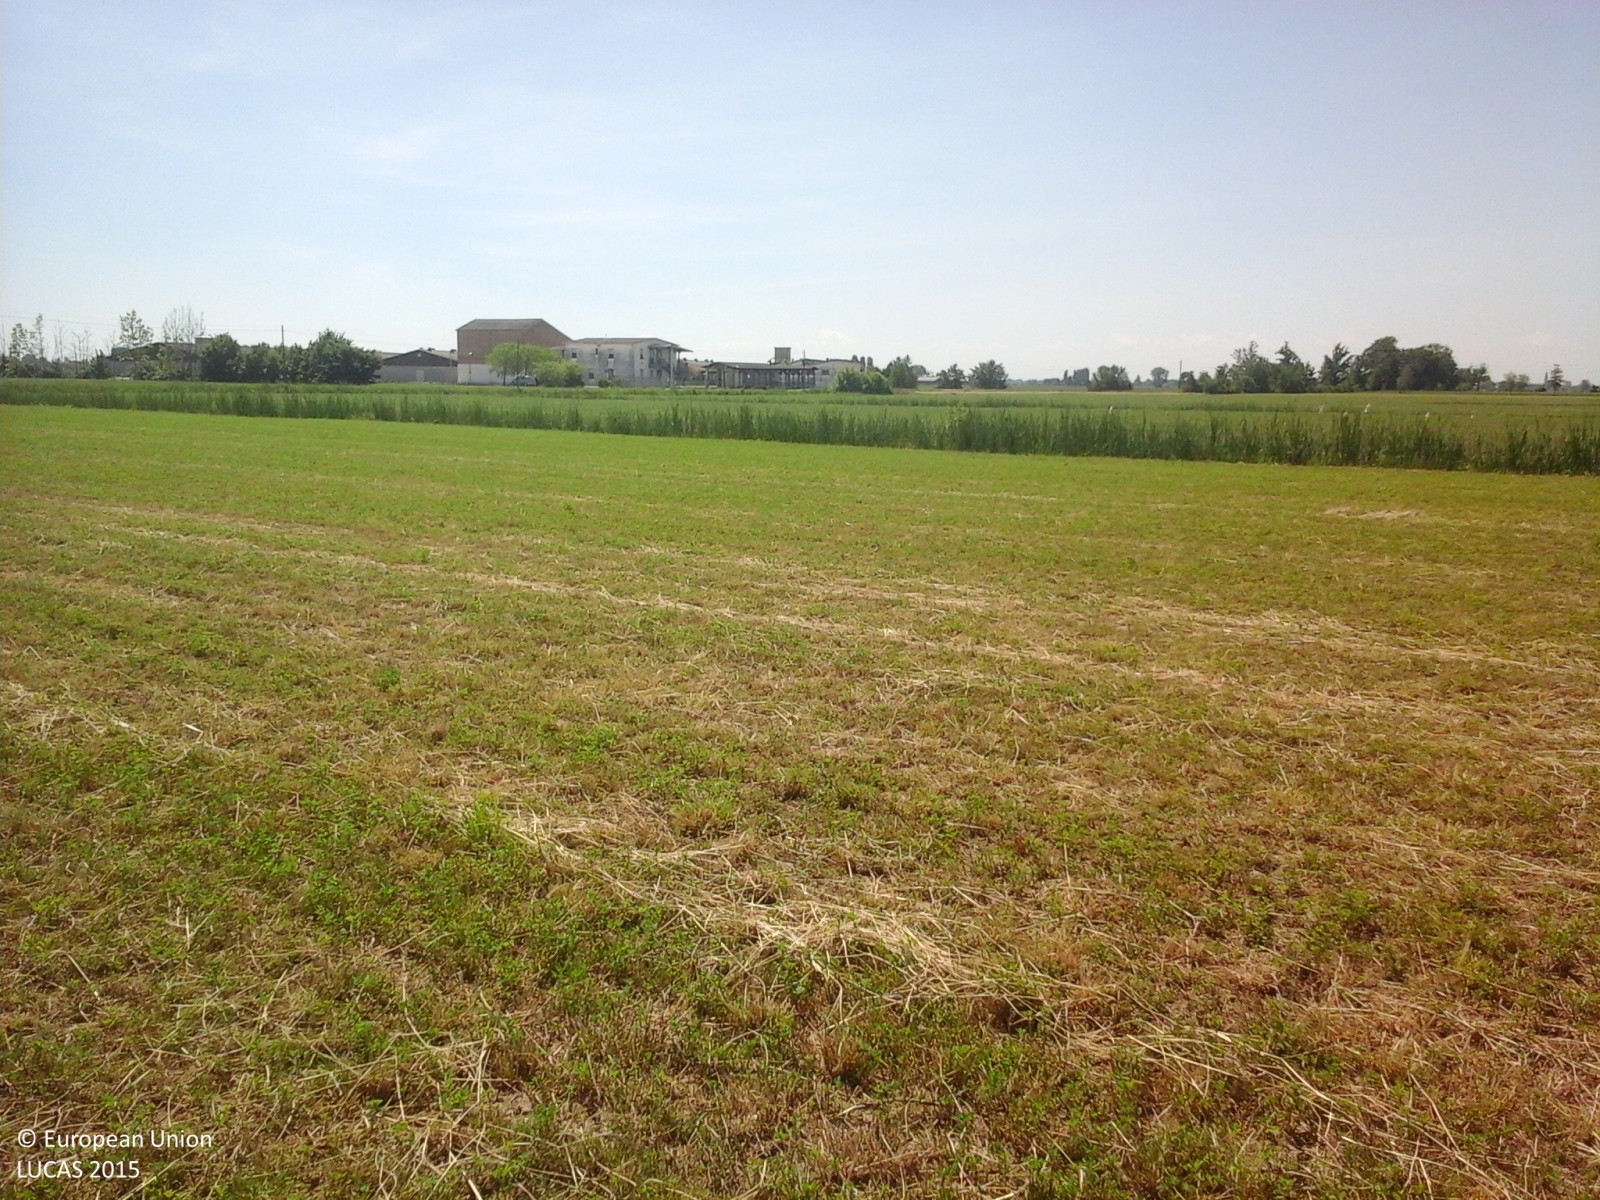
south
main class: Cropland
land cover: Lucerne
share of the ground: > 75 %
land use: Agriculture (excluding fallow land and kitchen gardens)
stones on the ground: < 10 %
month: May
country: IT
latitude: 44.9780
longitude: 10.8733
